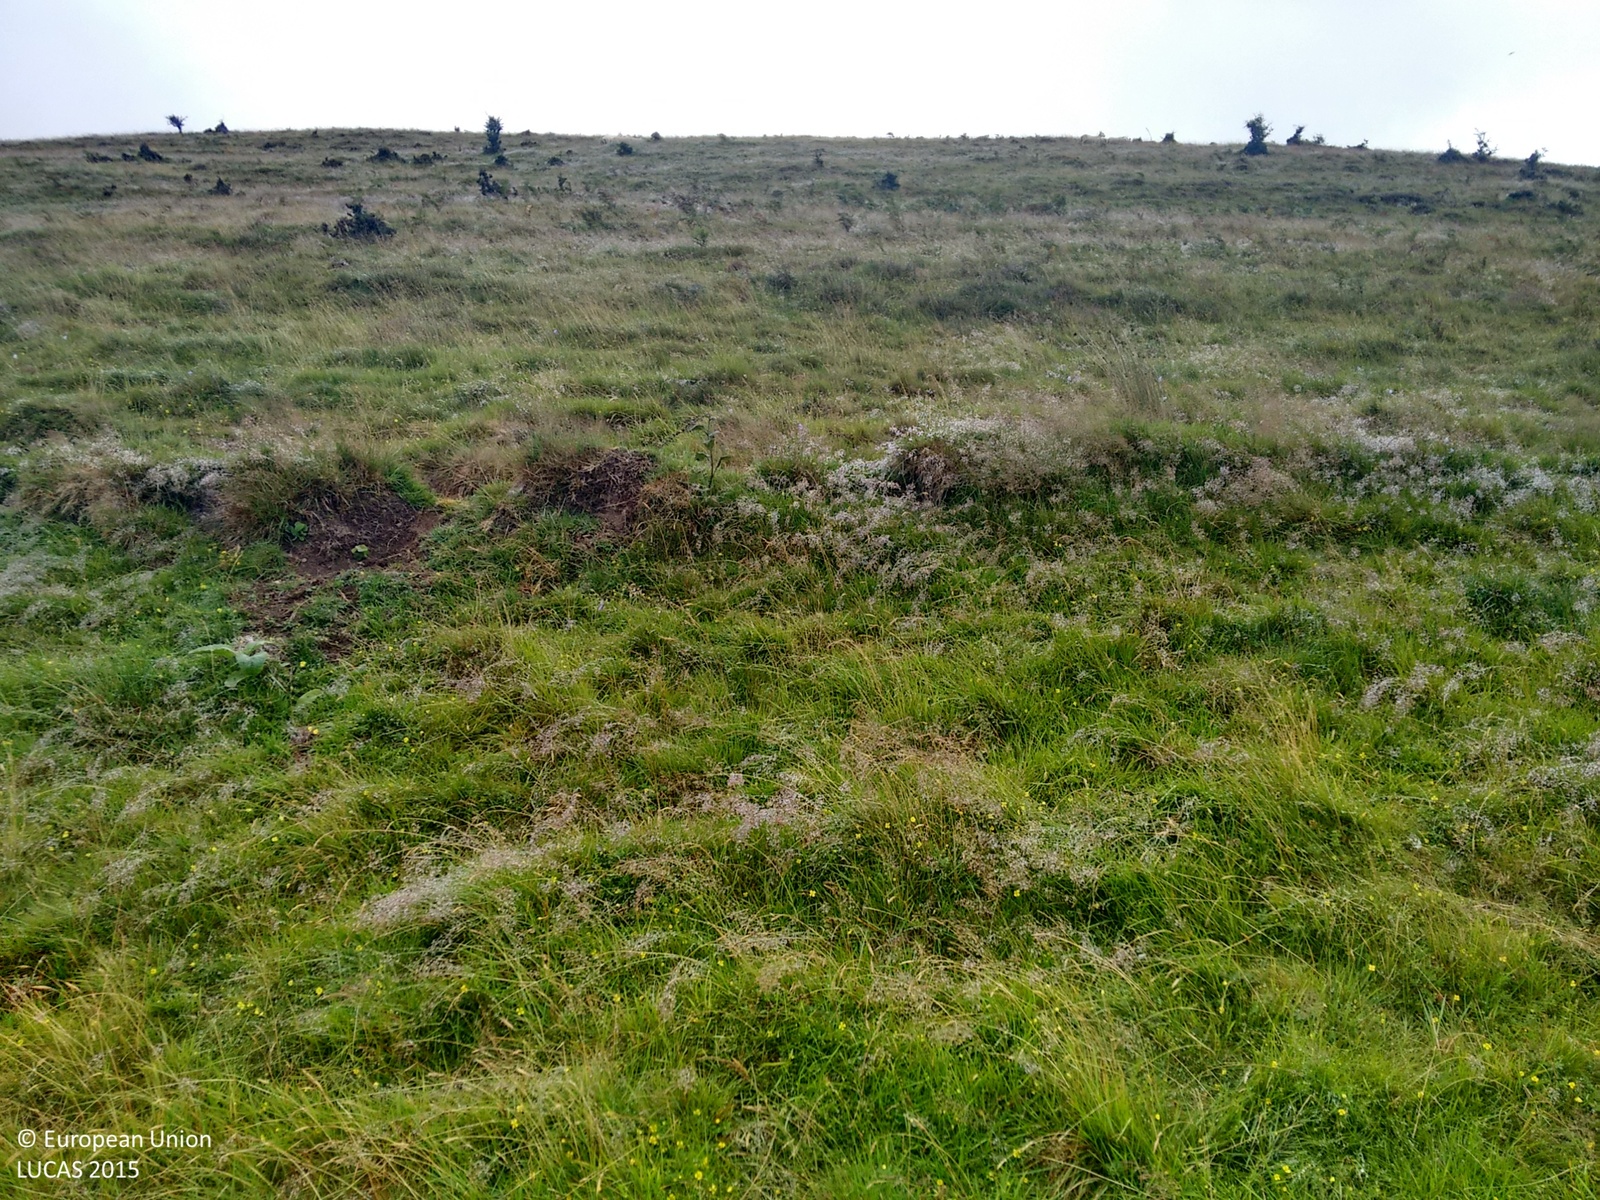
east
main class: Grassland
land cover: Grassland with sparse tree/shrub cover
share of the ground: > 75 %
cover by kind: herbaceous plants 90 %, broadleaved forest trees 5 %, shrubs 5 %
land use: Semi-natural and natural areas not in use
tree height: < 5 m
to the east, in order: Grassland with sparse tree/shrub cover; Tracks; Grassland without tree/shrub cover; Shrubland without tree cover; Spontaneously vegetated surfaces
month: August
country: GB
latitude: 55.1914
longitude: -3.0302
